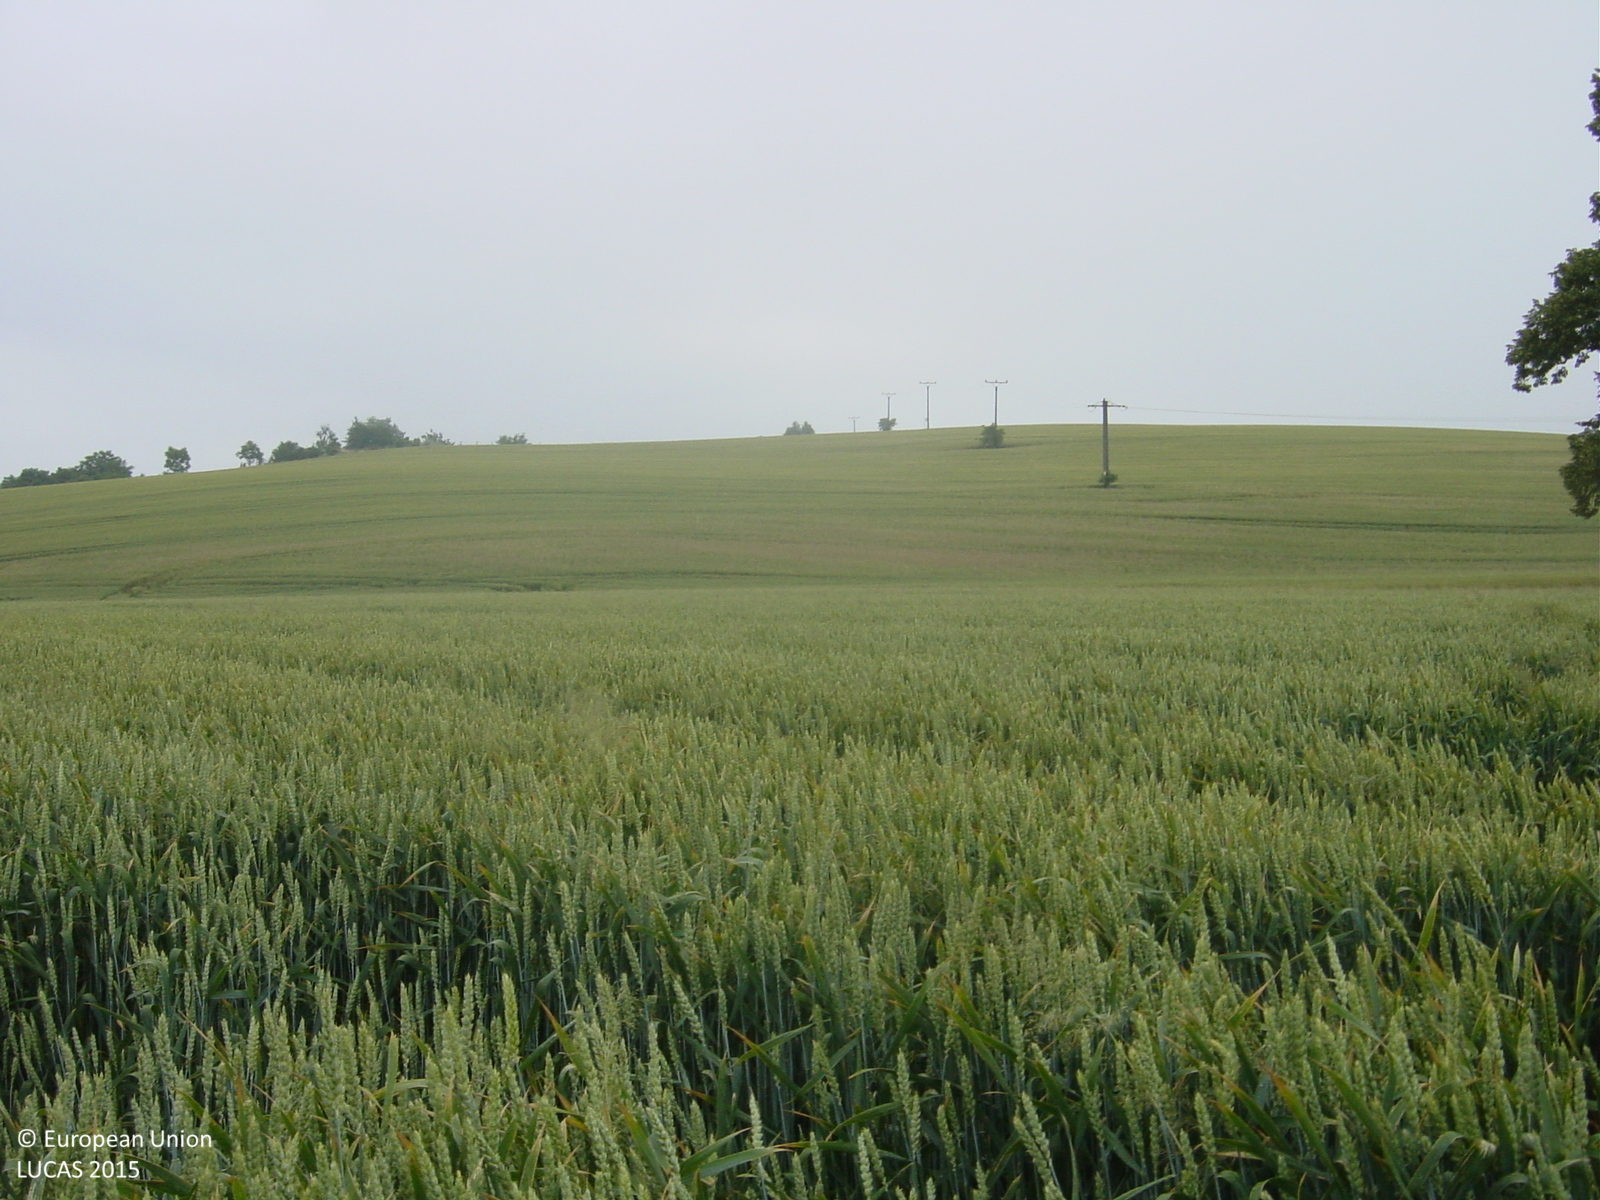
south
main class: Cropland
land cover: Common wheat
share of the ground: > 75 %
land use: Agriculture (excluding fallow land and kitchen gardens)
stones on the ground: < 10 %
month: June
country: CZ
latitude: 48.9392
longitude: 17.0125
